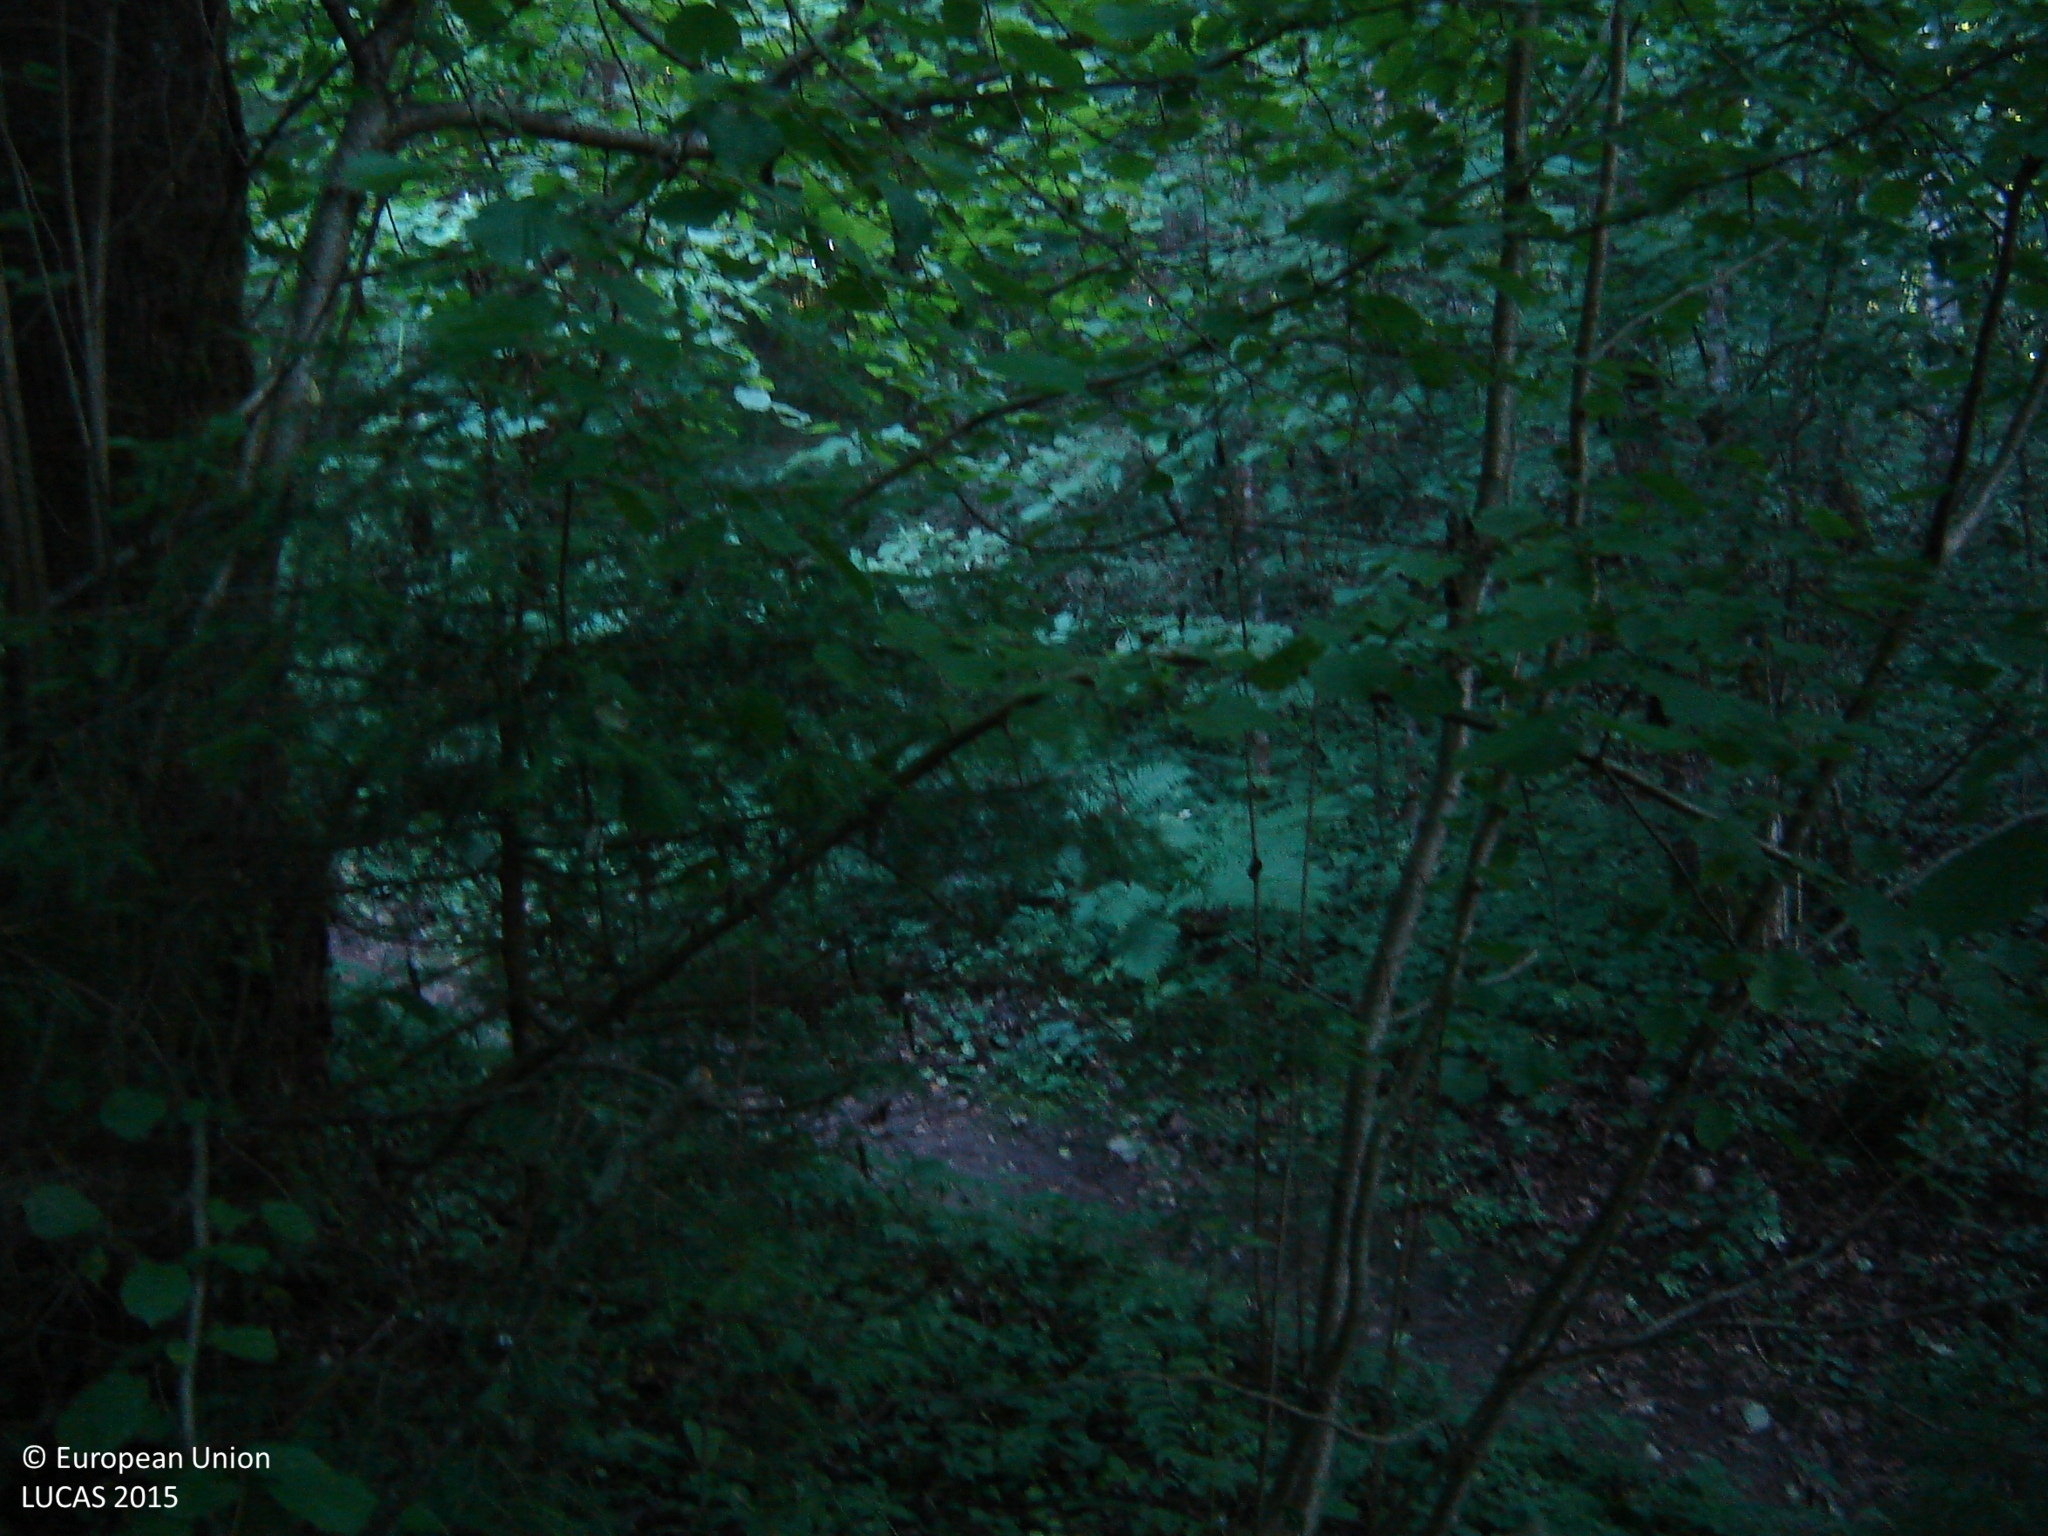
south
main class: Woodland
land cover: Broadleaved woodland
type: non-riverine alder, birch or aspen forest
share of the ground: > 75 %
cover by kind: broadleaved forest trees 85 %, coniferous forest trees 10 %, herbaceous plants 5 %
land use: Forestry
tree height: > 5 m
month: July
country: LT
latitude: 55.4918
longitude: 25.0705
